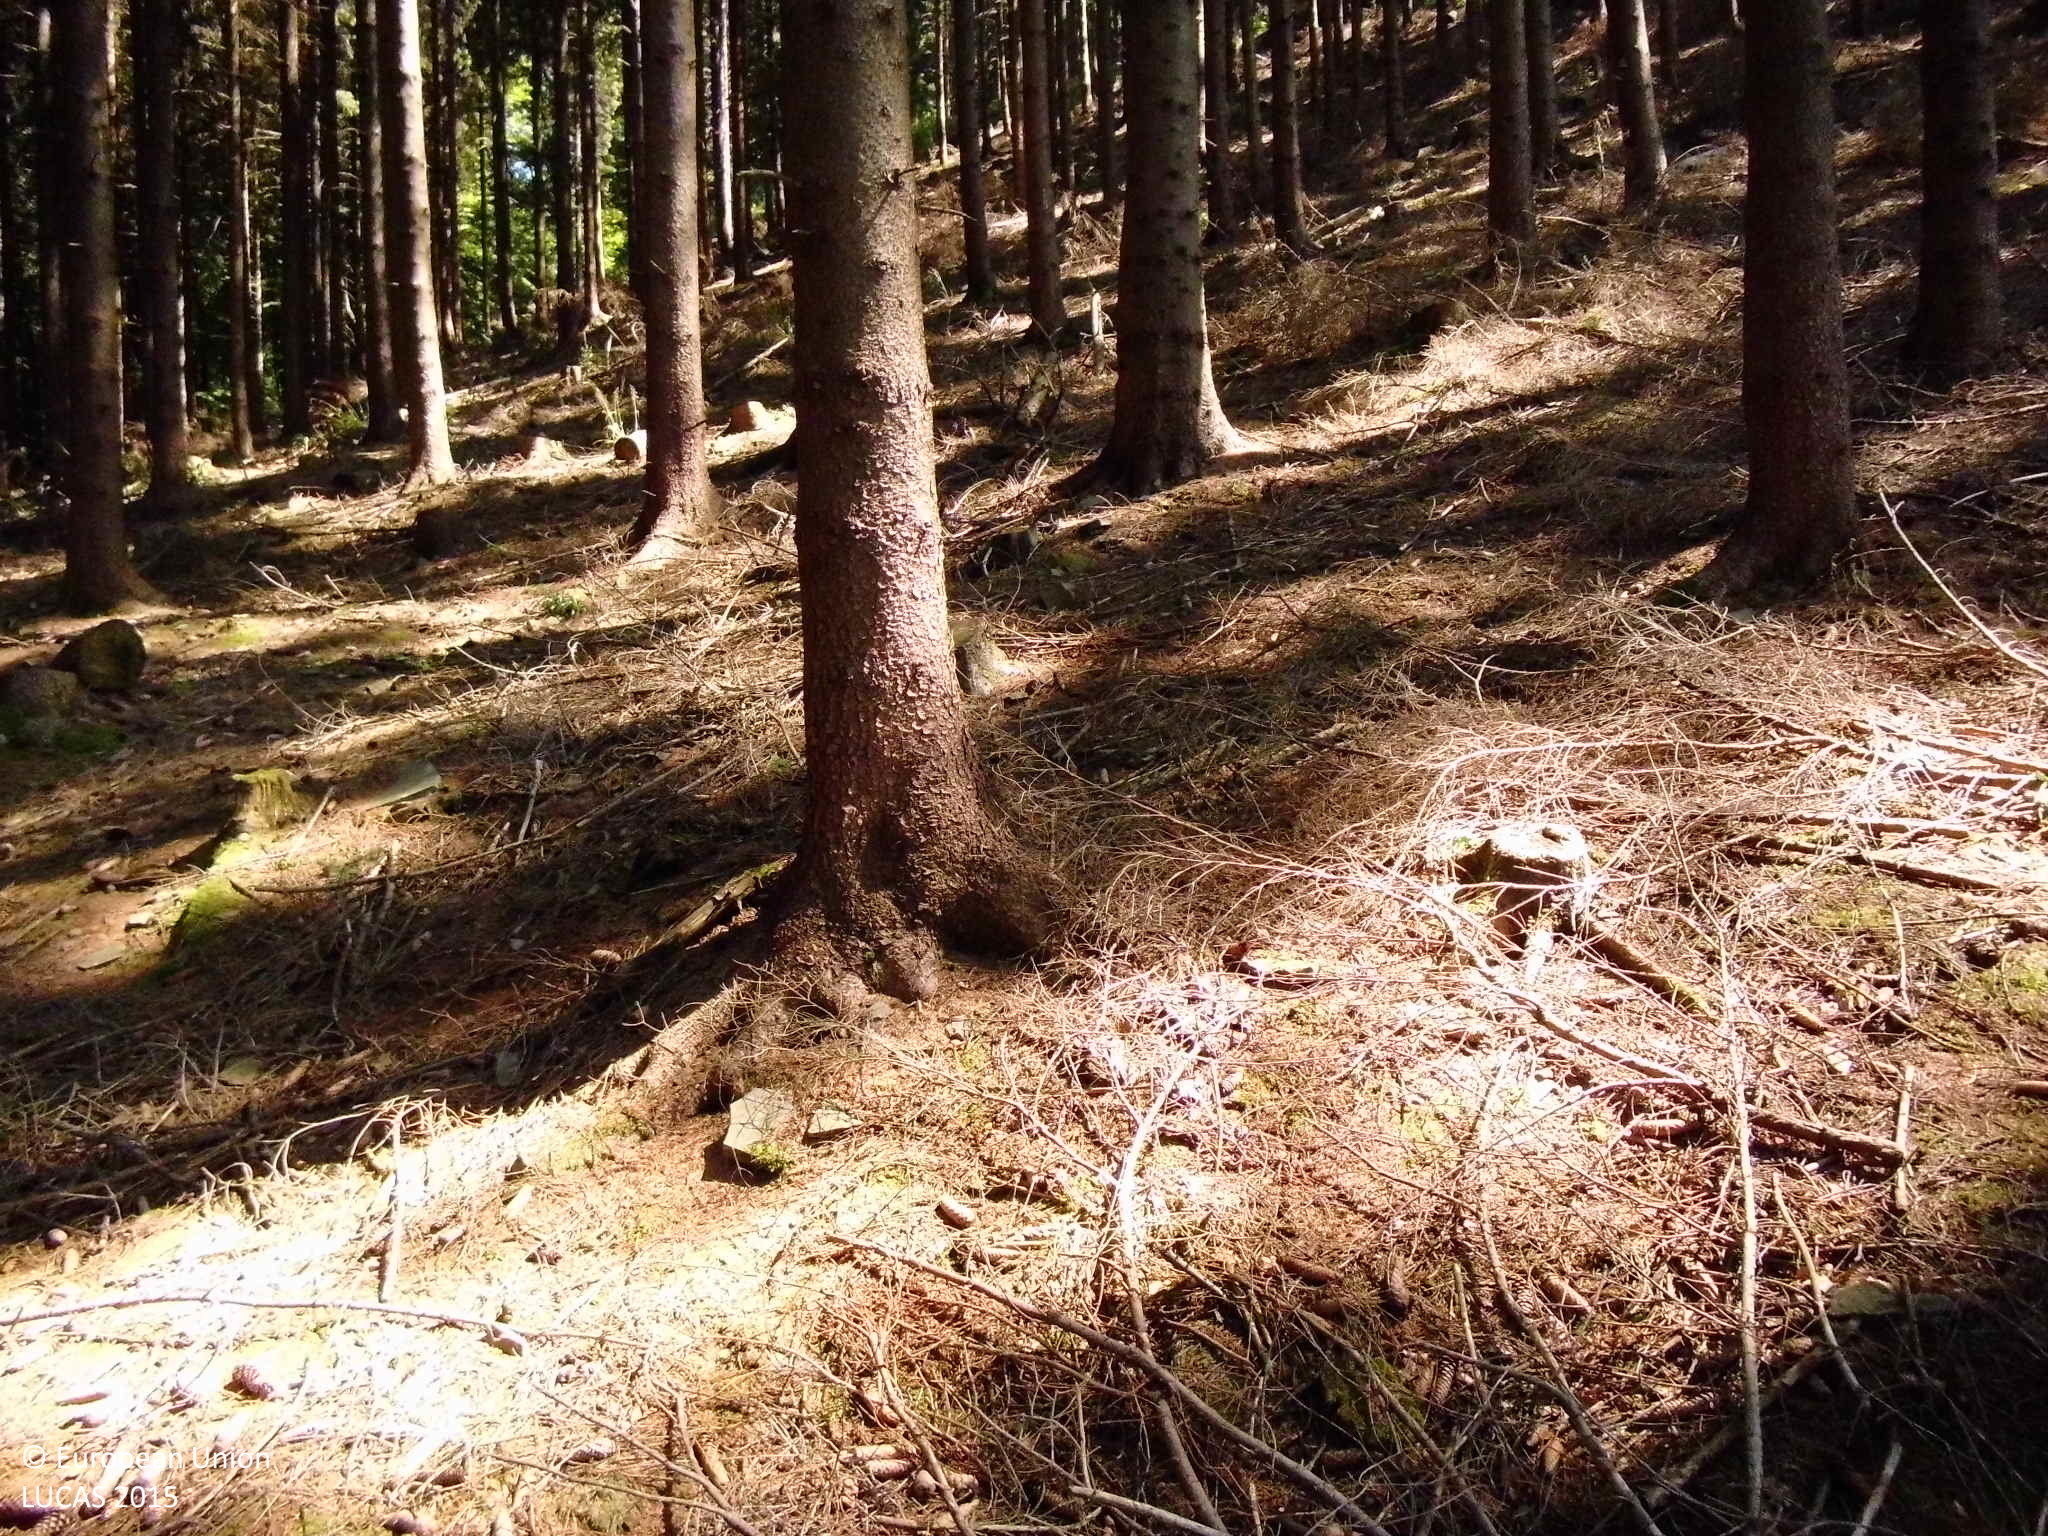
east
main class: Woodland
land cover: Spruce dominated coniferous woodland
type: hemiboreal forest and nemoral coniferous forest and mixed broadleaved-coniferous forest
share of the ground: > 75 %
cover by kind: coniferous forest trees 95 %, herbaceous plants 5 %
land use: Forestry
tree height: > 5 m
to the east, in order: Spruce dominated coniferous woodland; Tracks; Spruce dominated coniferous woodland; Spruce dominated mixed woodland; Broadleaved woodland; Spruce dominated coniferous woodland; Broadleaved woodland
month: August
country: DE
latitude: 51.2095
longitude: 7.9820
